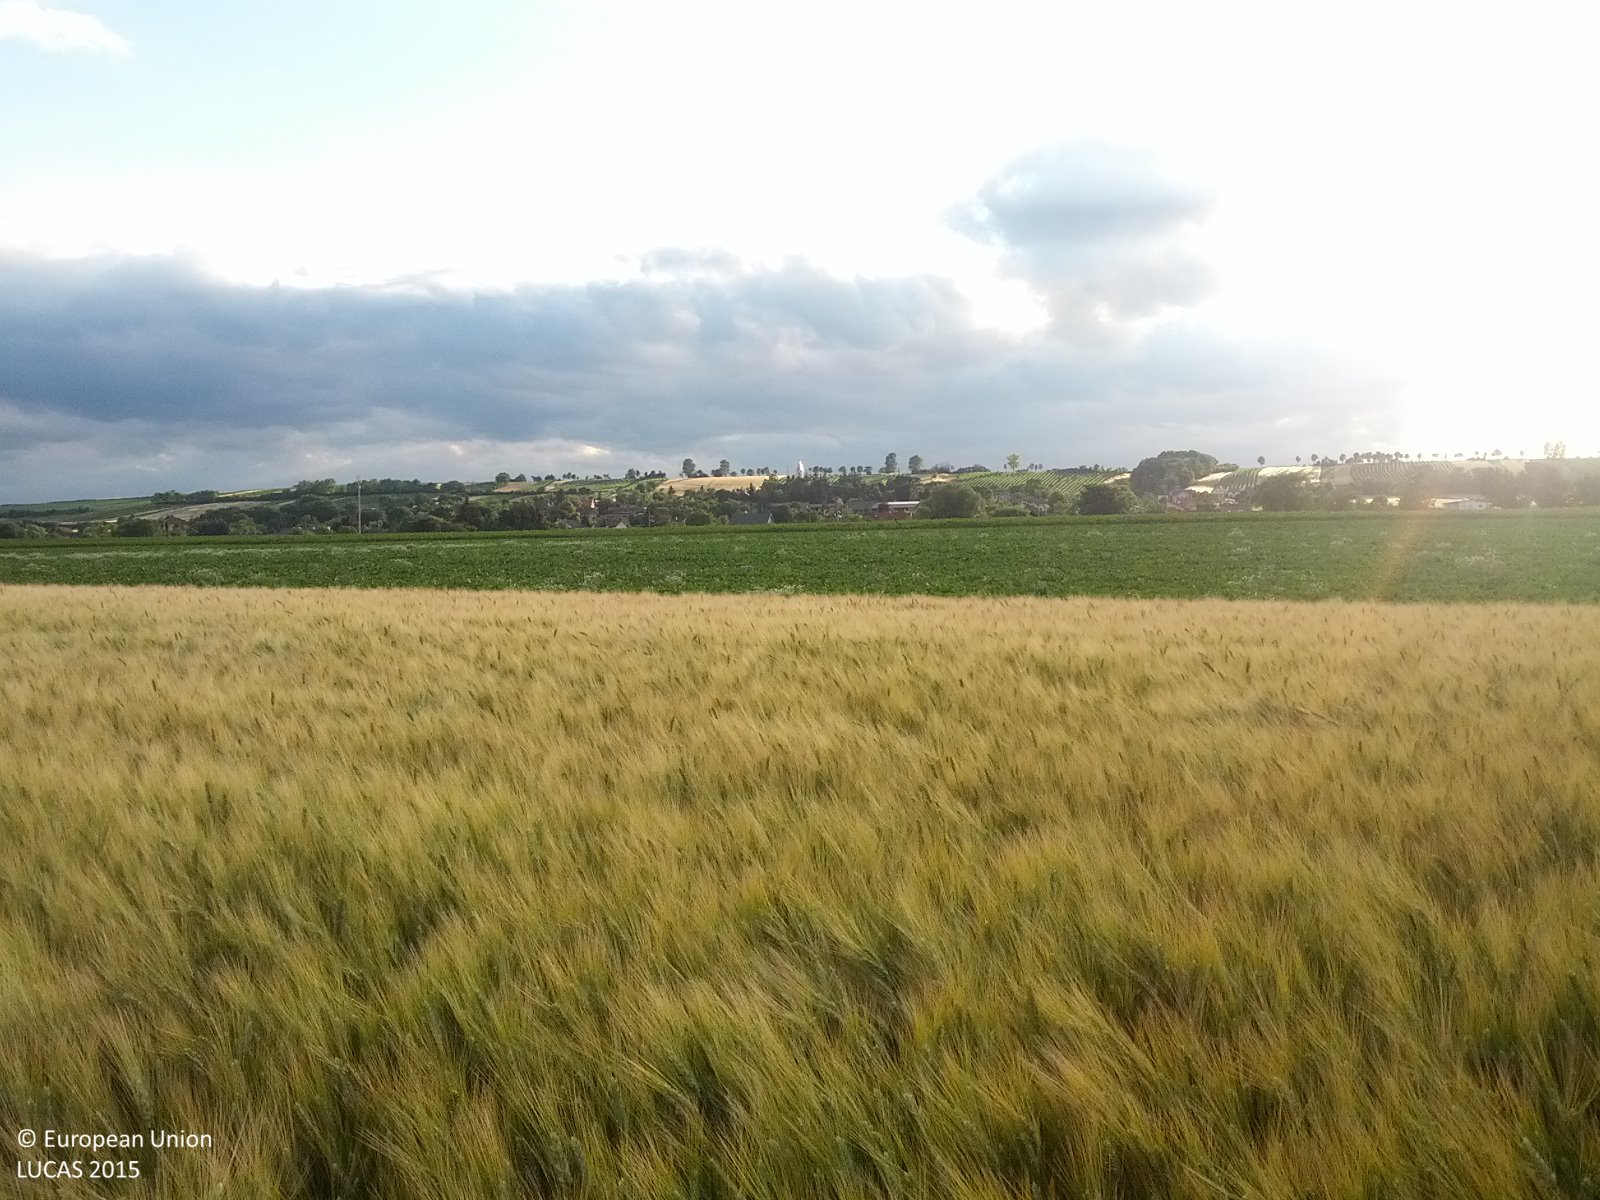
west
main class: Cropland
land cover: Barley
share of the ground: > 75 %
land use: Agriculture (excluding fallow land and kitchen gardens)
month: June
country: AT
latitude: 48.5130
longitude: 16.8981
